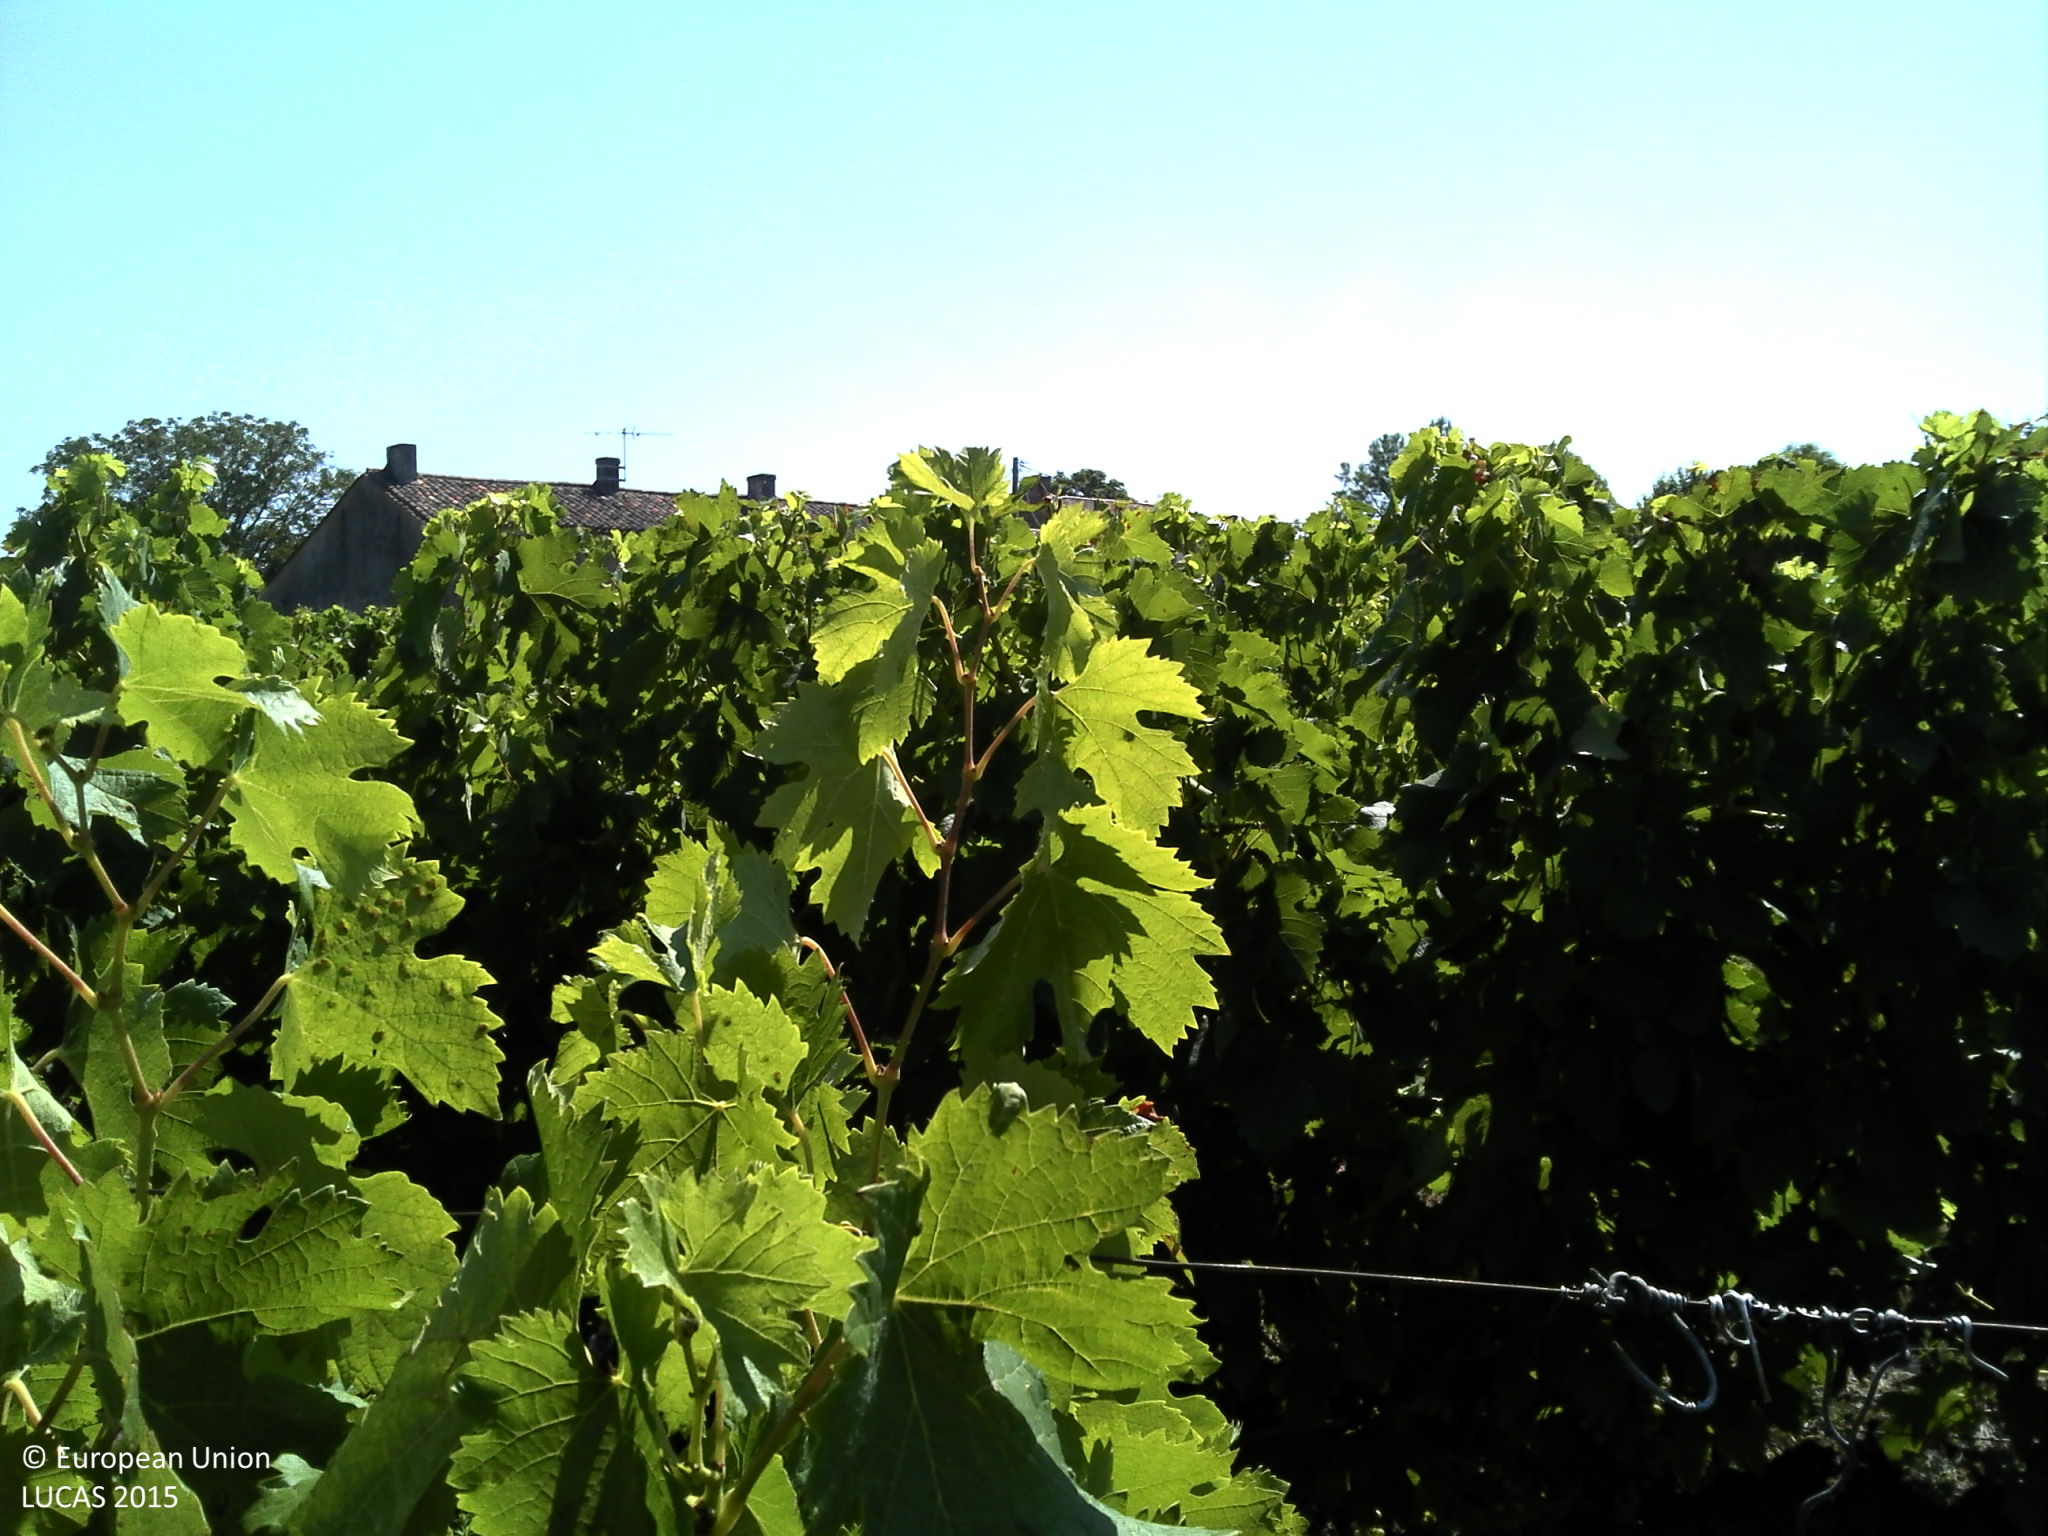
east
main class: Cropland
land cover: Vineyards
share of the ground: 25 - 50 %
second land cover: Grassland without tree/shrub cover
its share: > 75 %
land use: Agriculture (excluding fallow land and kitchen gardens)
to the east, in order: Vineyards; Grassland without tree/shrub cover; Artificial constructions in urban areas; Grassland without tree/shrub cover; Vineyards; Grassland without tree/shrub cover; Dry stone walls; Electric lines; Grass margins; Artificial constructions in urban areas
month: August
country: FR
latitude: 45.0195
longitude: -0.4625
